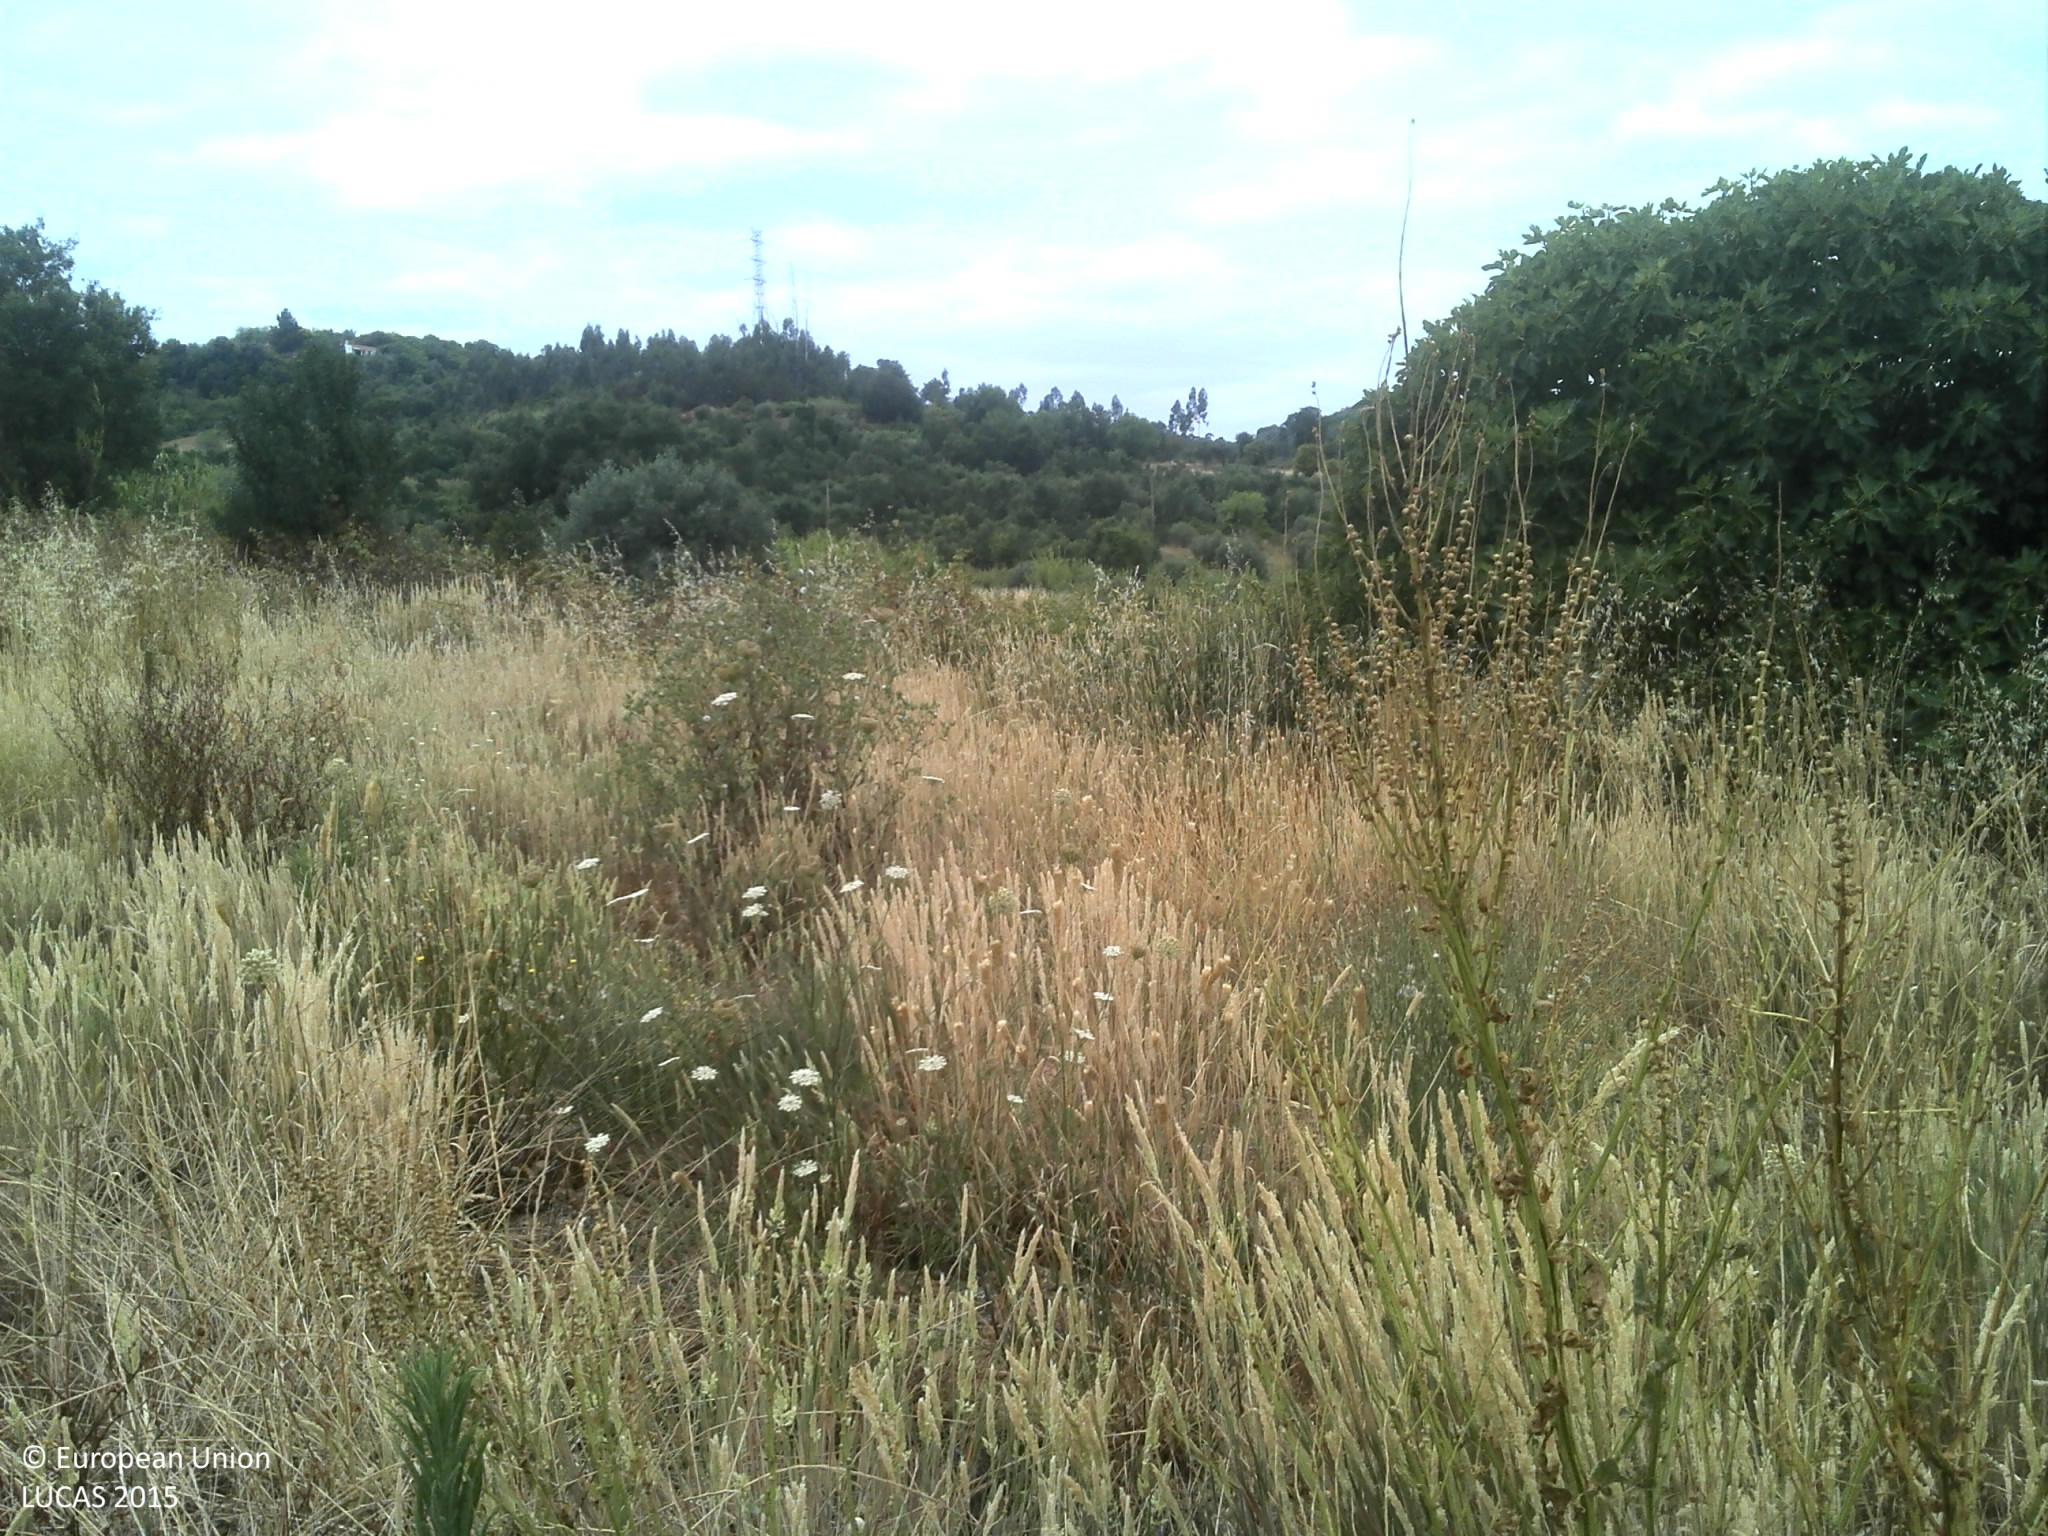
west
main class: Shrubland
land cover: Shrubland without tree cover
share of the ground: 50 - 75 %
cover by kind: shrubs 60 %, unconsolidated bare surface 30 %, herbaceous plants 10 %
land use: Abandoned areas
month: June
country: PT
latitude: 39.2221
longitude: -8.7339
